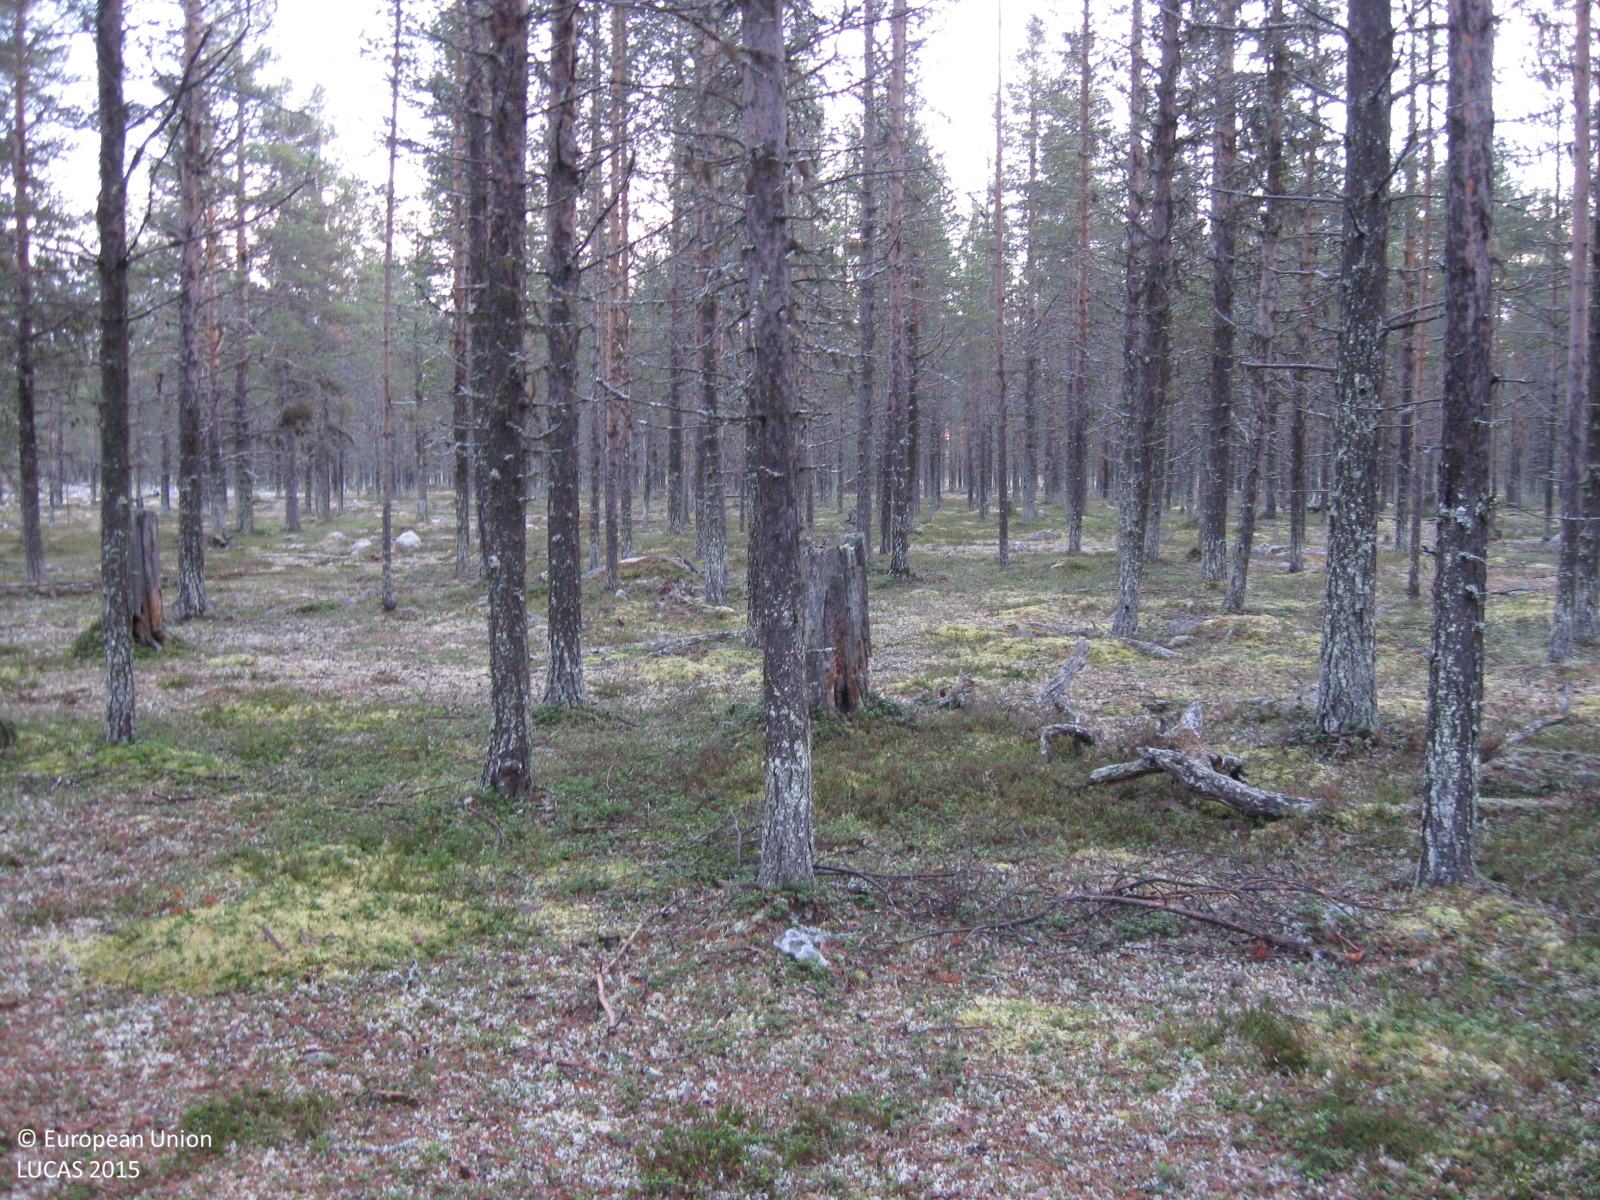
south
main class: Woodland
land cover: Pine dominated coniferous woodland
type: boreal forest
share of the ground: 50 - 75 %
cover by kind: coniferous forest trees 50 %, shrubs 20 %, lichens and mosses 20 %, herbaceous plants 5 %, unconsolidated bare surface 5 %
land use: Forestry
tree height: > 5 m
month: October
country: SE
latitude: 66.6094
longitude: 21.0413
